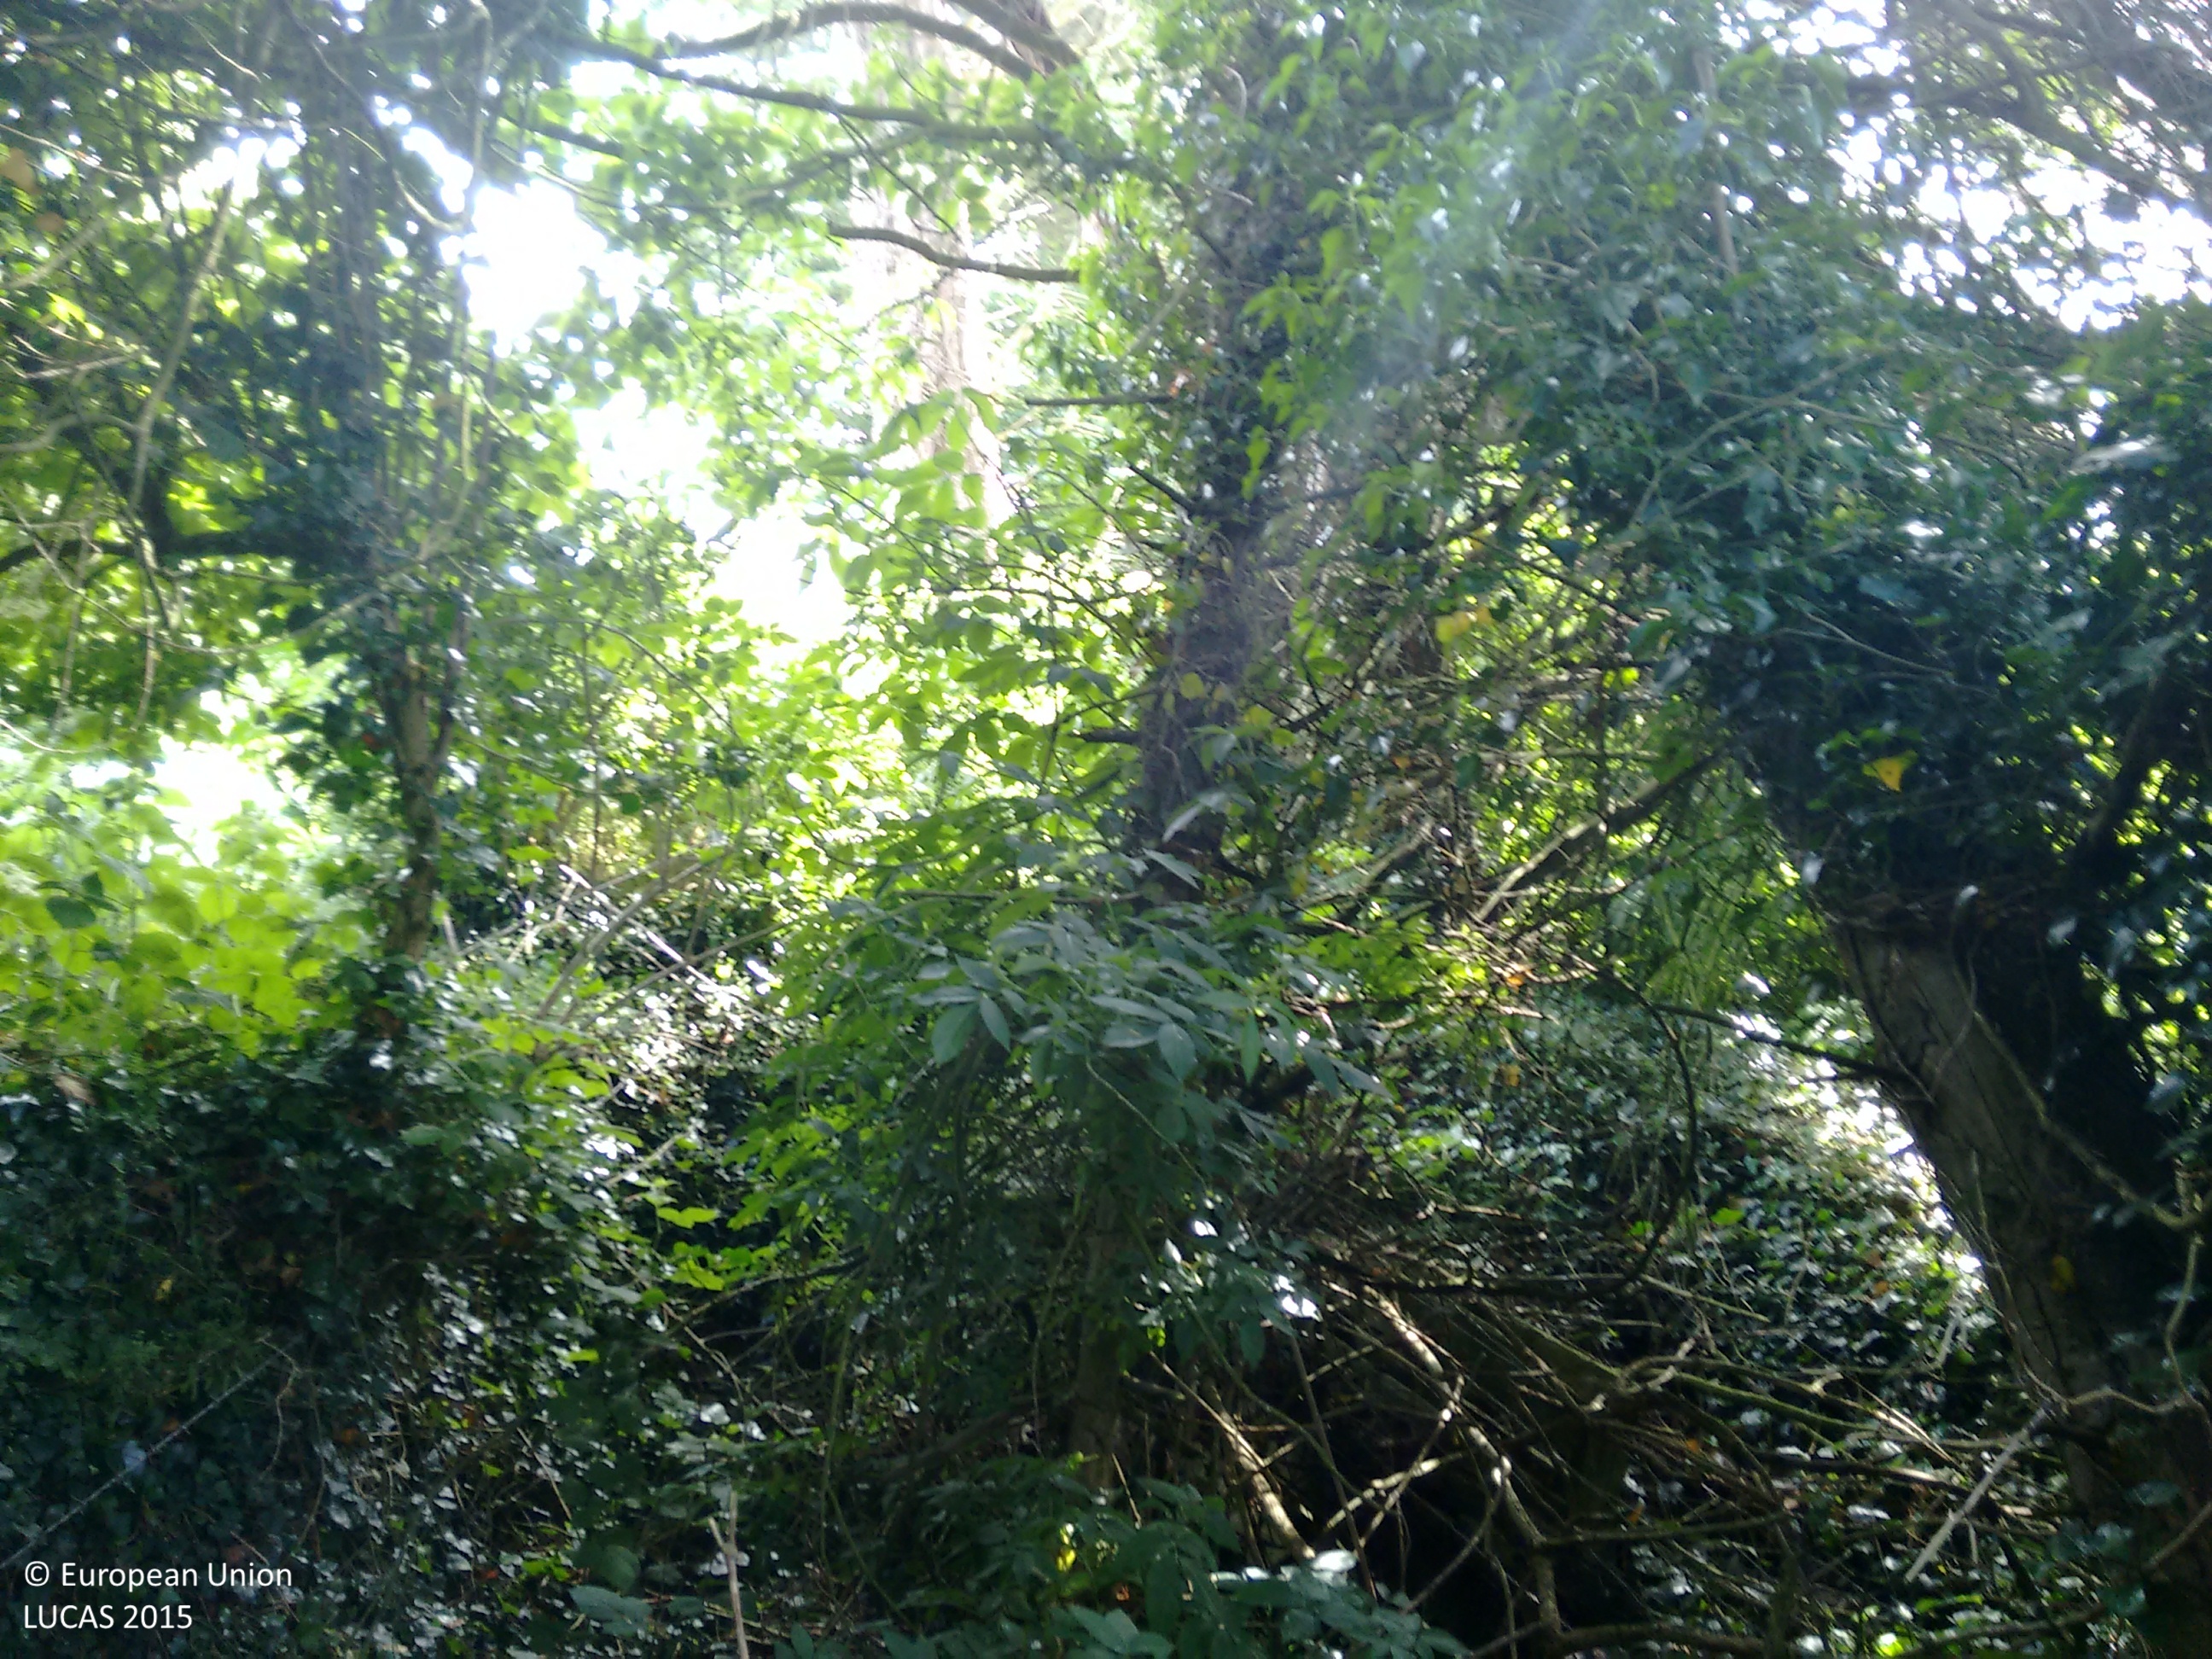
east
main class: Woodland
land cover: Broadleaved woodland
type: mesophytic deciduous forest
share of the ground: > 75 %
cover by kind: broadleaved forest trees 60 %, coniferous forest trees 20 %, shrubs 20 %
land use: Semi-natural and natural areas not in use
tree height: > 5 m
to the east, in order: Broadleaved woodland; Managed hedges; Fences; Paved roads, cycling and walking lanes; Managed hedges; Grassland without tree/shrub cover; Electric lines; Grassland without tree/shrub cover; Spontaneously vegetated surfaces; Fences; Other bare soil
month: June
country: IE
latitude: 53.6987
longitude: -6.7181
